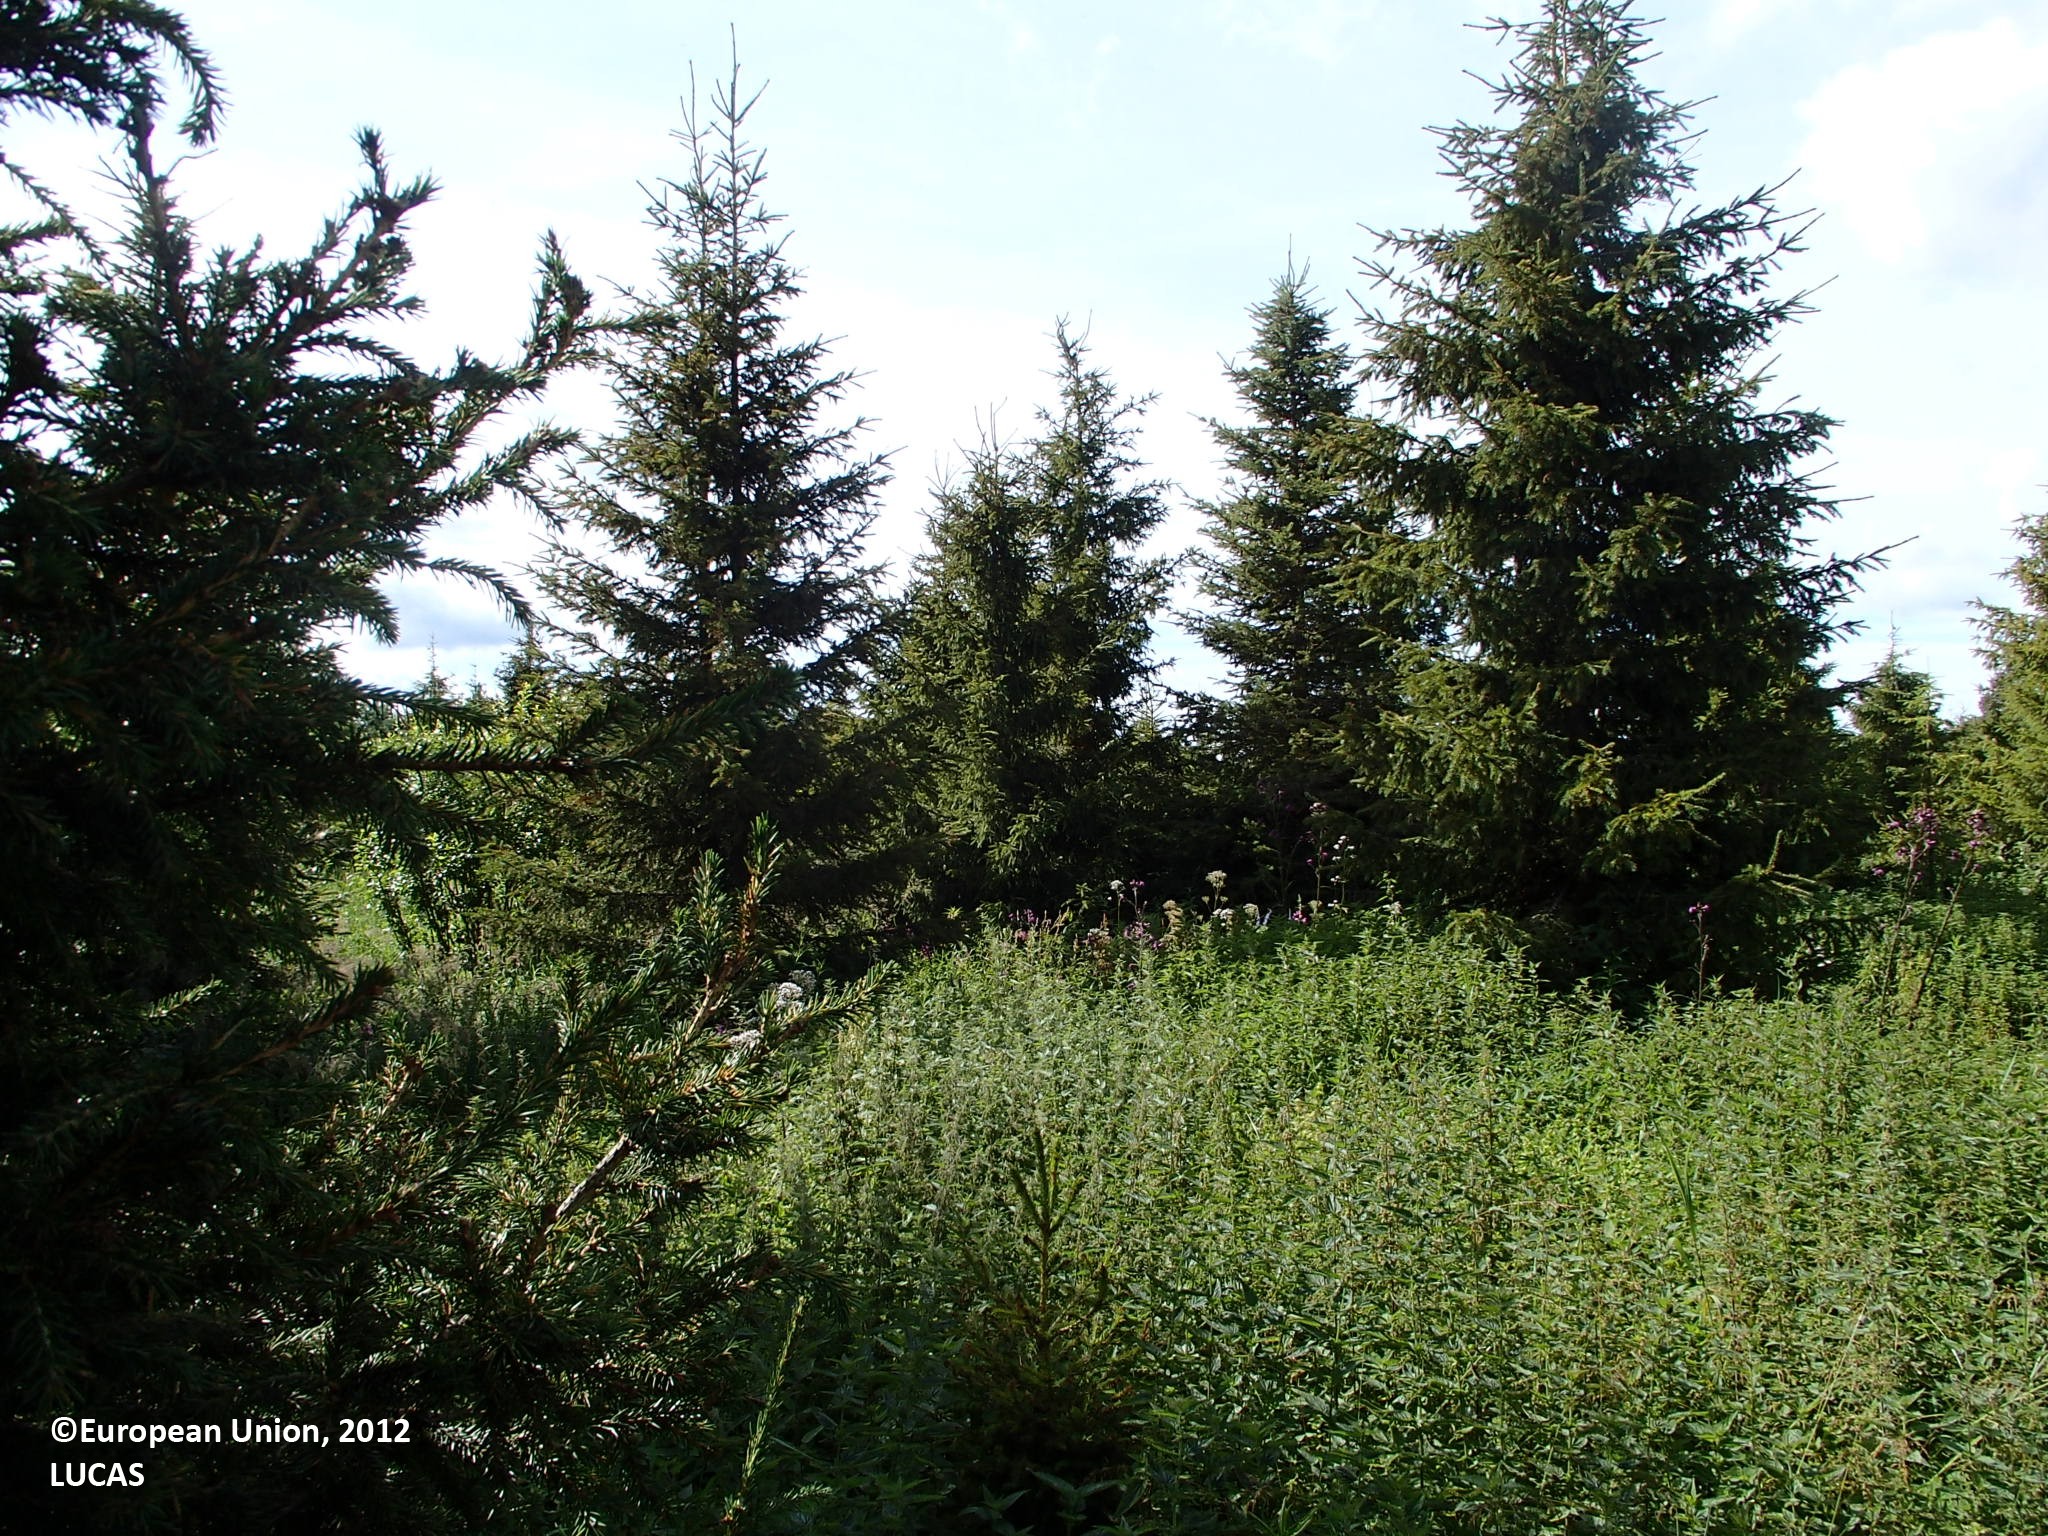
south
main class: Woodland
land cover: Spruce dominated coniferous woodland
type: boreal forest
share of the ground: 25 - 50 %
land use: Forestry
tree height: > 5 m
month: August
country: FI
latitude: 66.2372
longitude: 25.5249
